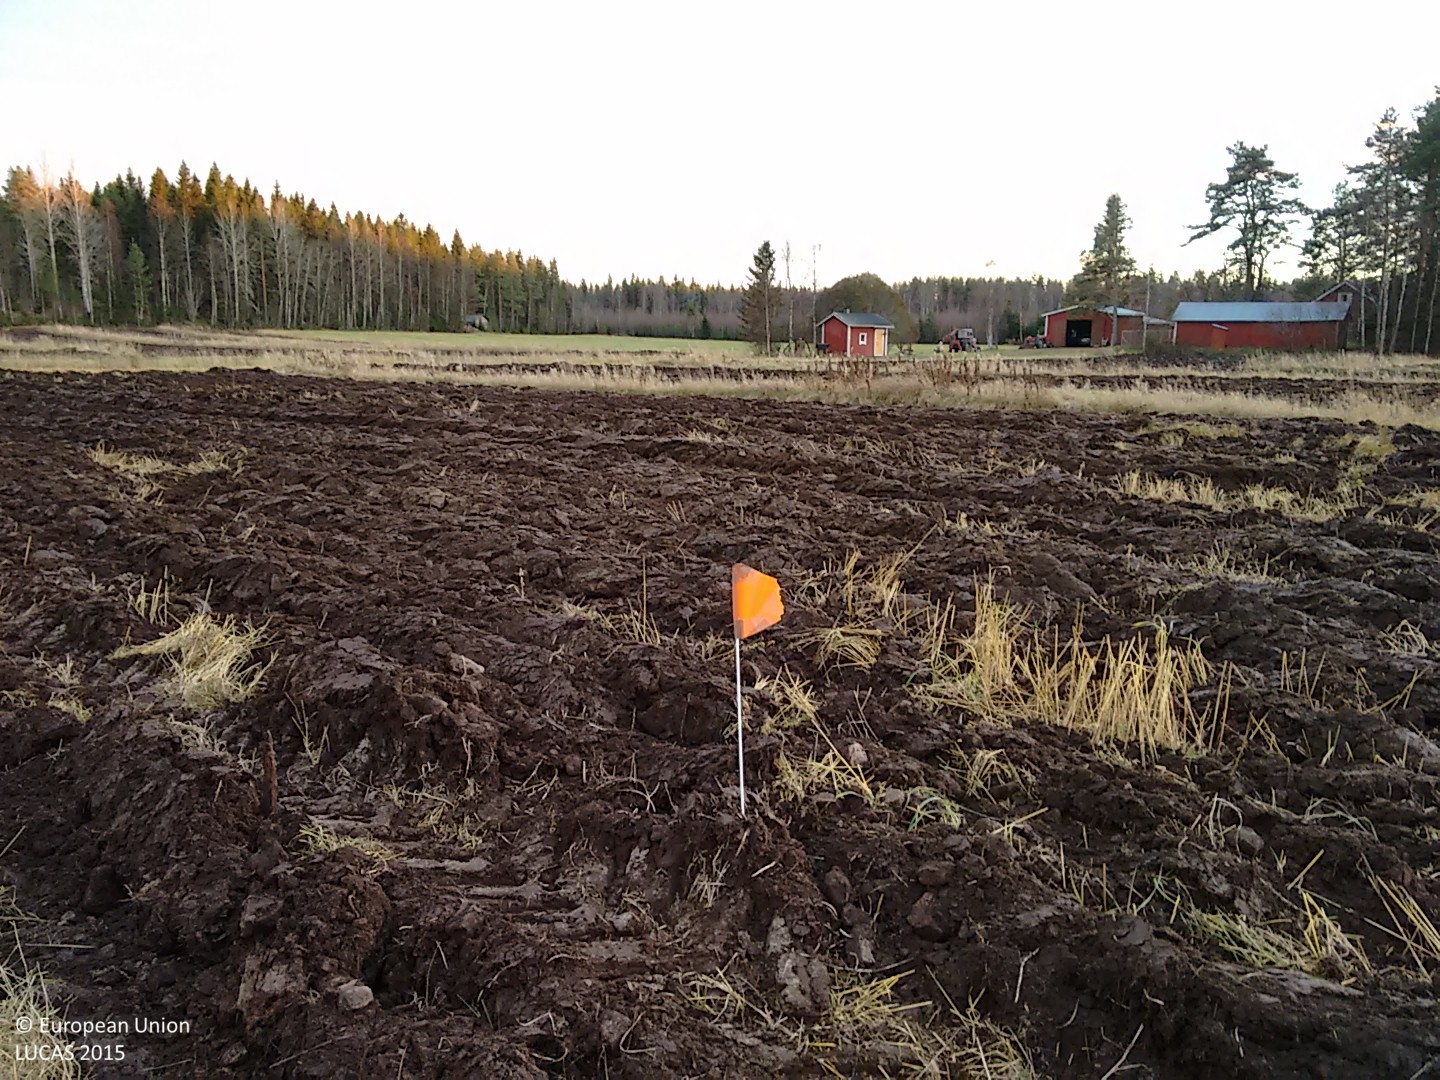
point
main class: Cropland
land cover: Oats
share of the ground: < 10 %
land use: Agriculture (excluding fallow land and kitchen gardens)
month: October
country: FI
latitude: 64.6350
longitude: 24.6530
